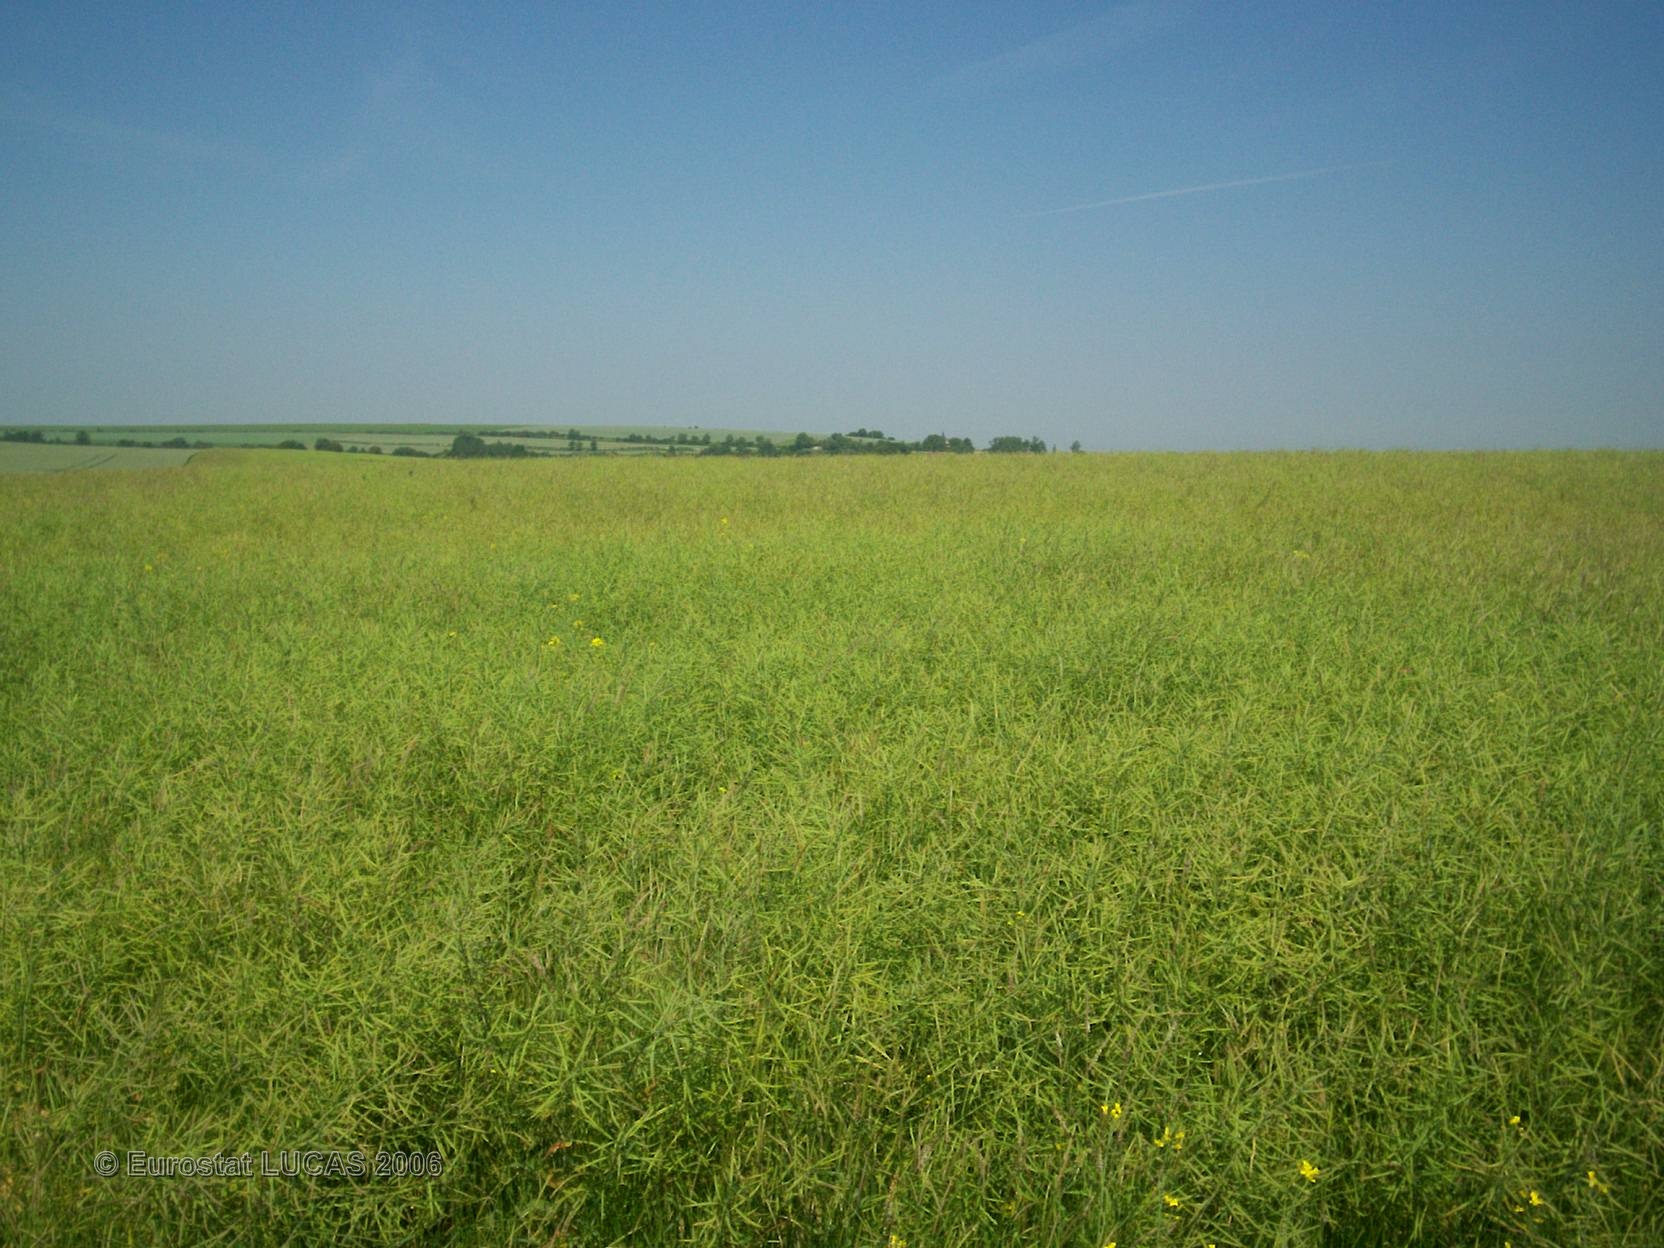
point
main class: Cropland
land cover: Rape and turnip rape
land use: Agriculture (excluding fallow land and kitchen gardens)
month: June
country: FR
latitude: 49.0389
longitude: 4.8129
